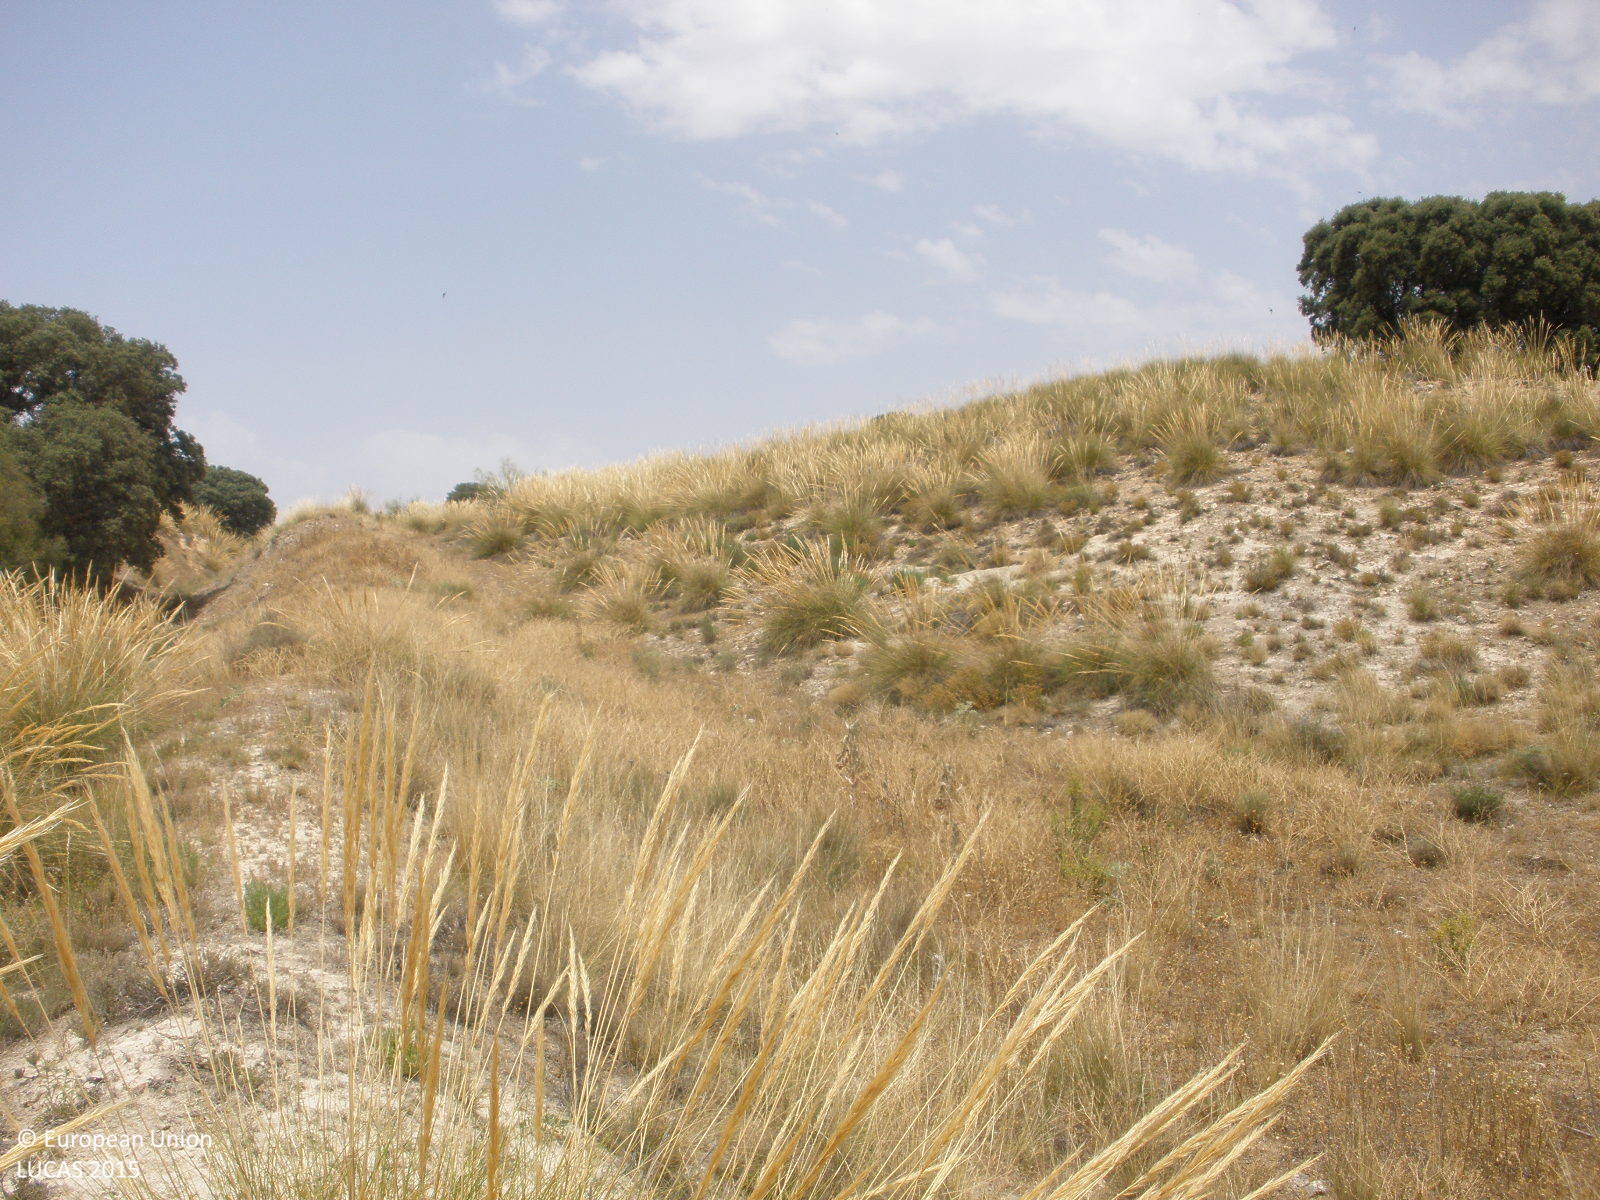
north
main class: Grassland
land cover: Grassland with sparse tree/shrub cover
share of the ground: 50 - 75 %
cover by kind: herbaceous plants 65 %, consolidated bare surface 25 %, broadleaved forest trees 5 %, shrubs 5 %
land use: Semi-natural and natural areas not in use
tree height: < 5 m
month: July
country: ES
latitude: 39.8613
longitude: -3.3639
